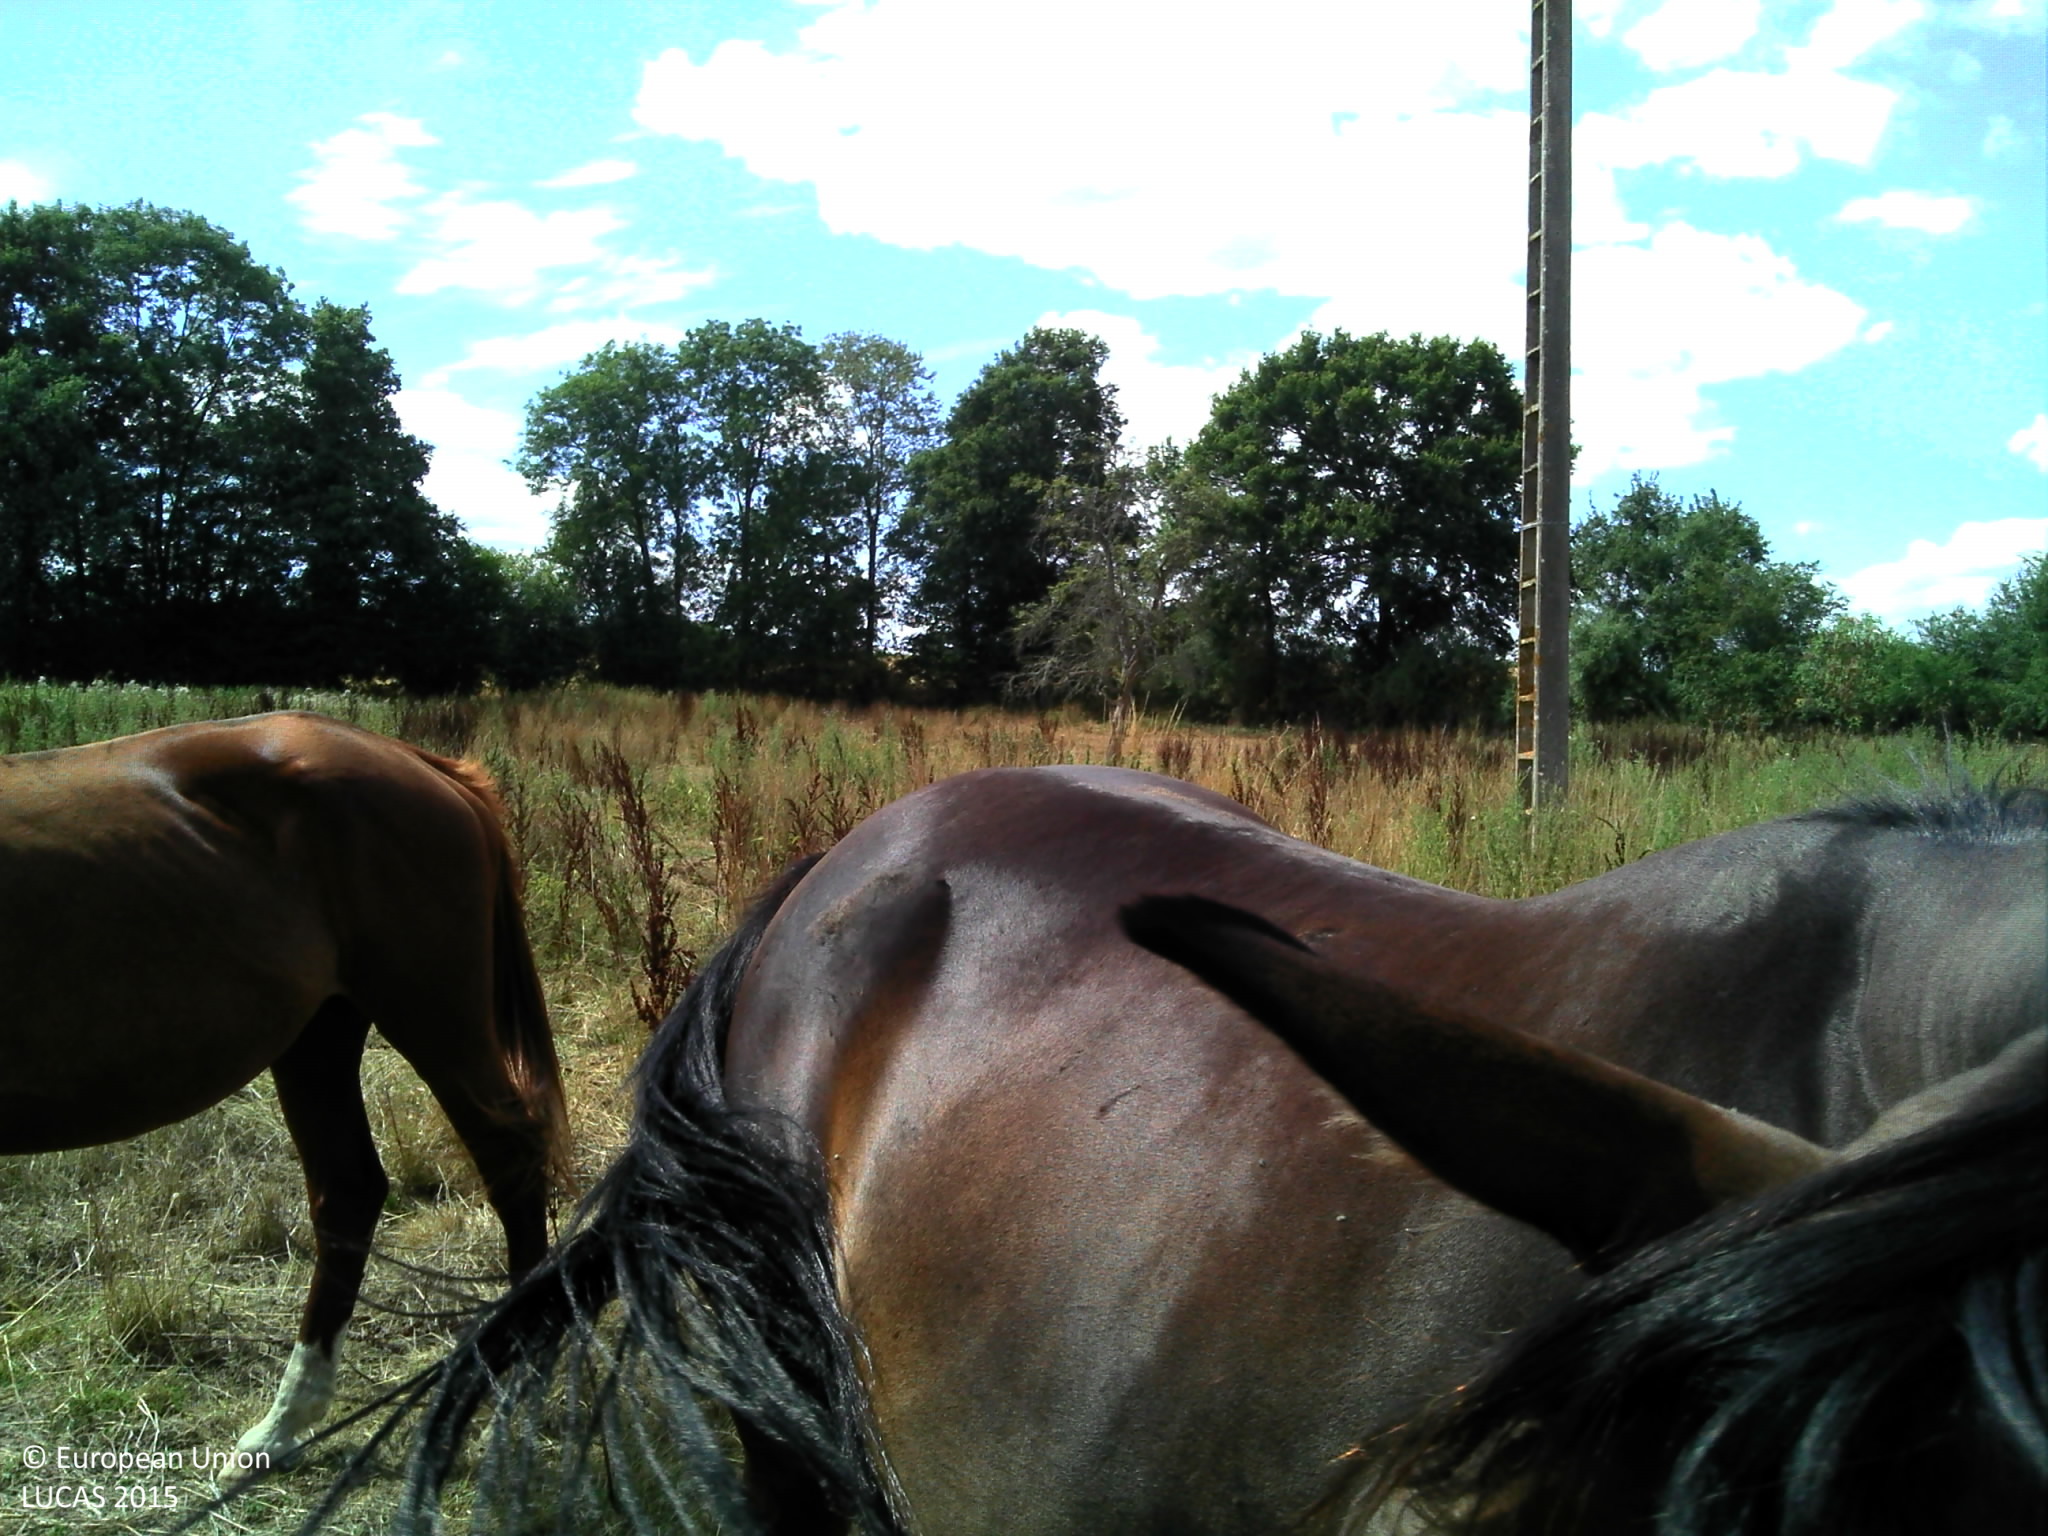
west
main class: Grassland
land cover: Grassland without tree/shrub cover
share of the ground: > 75 %
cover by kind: herbaceous plants 80 %, unconsolidated bare surface 20 %
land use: Agriculture (excluding fallow land and kitchen gardens)
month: July
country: FR
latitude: 47.8259
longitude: 3.0878
